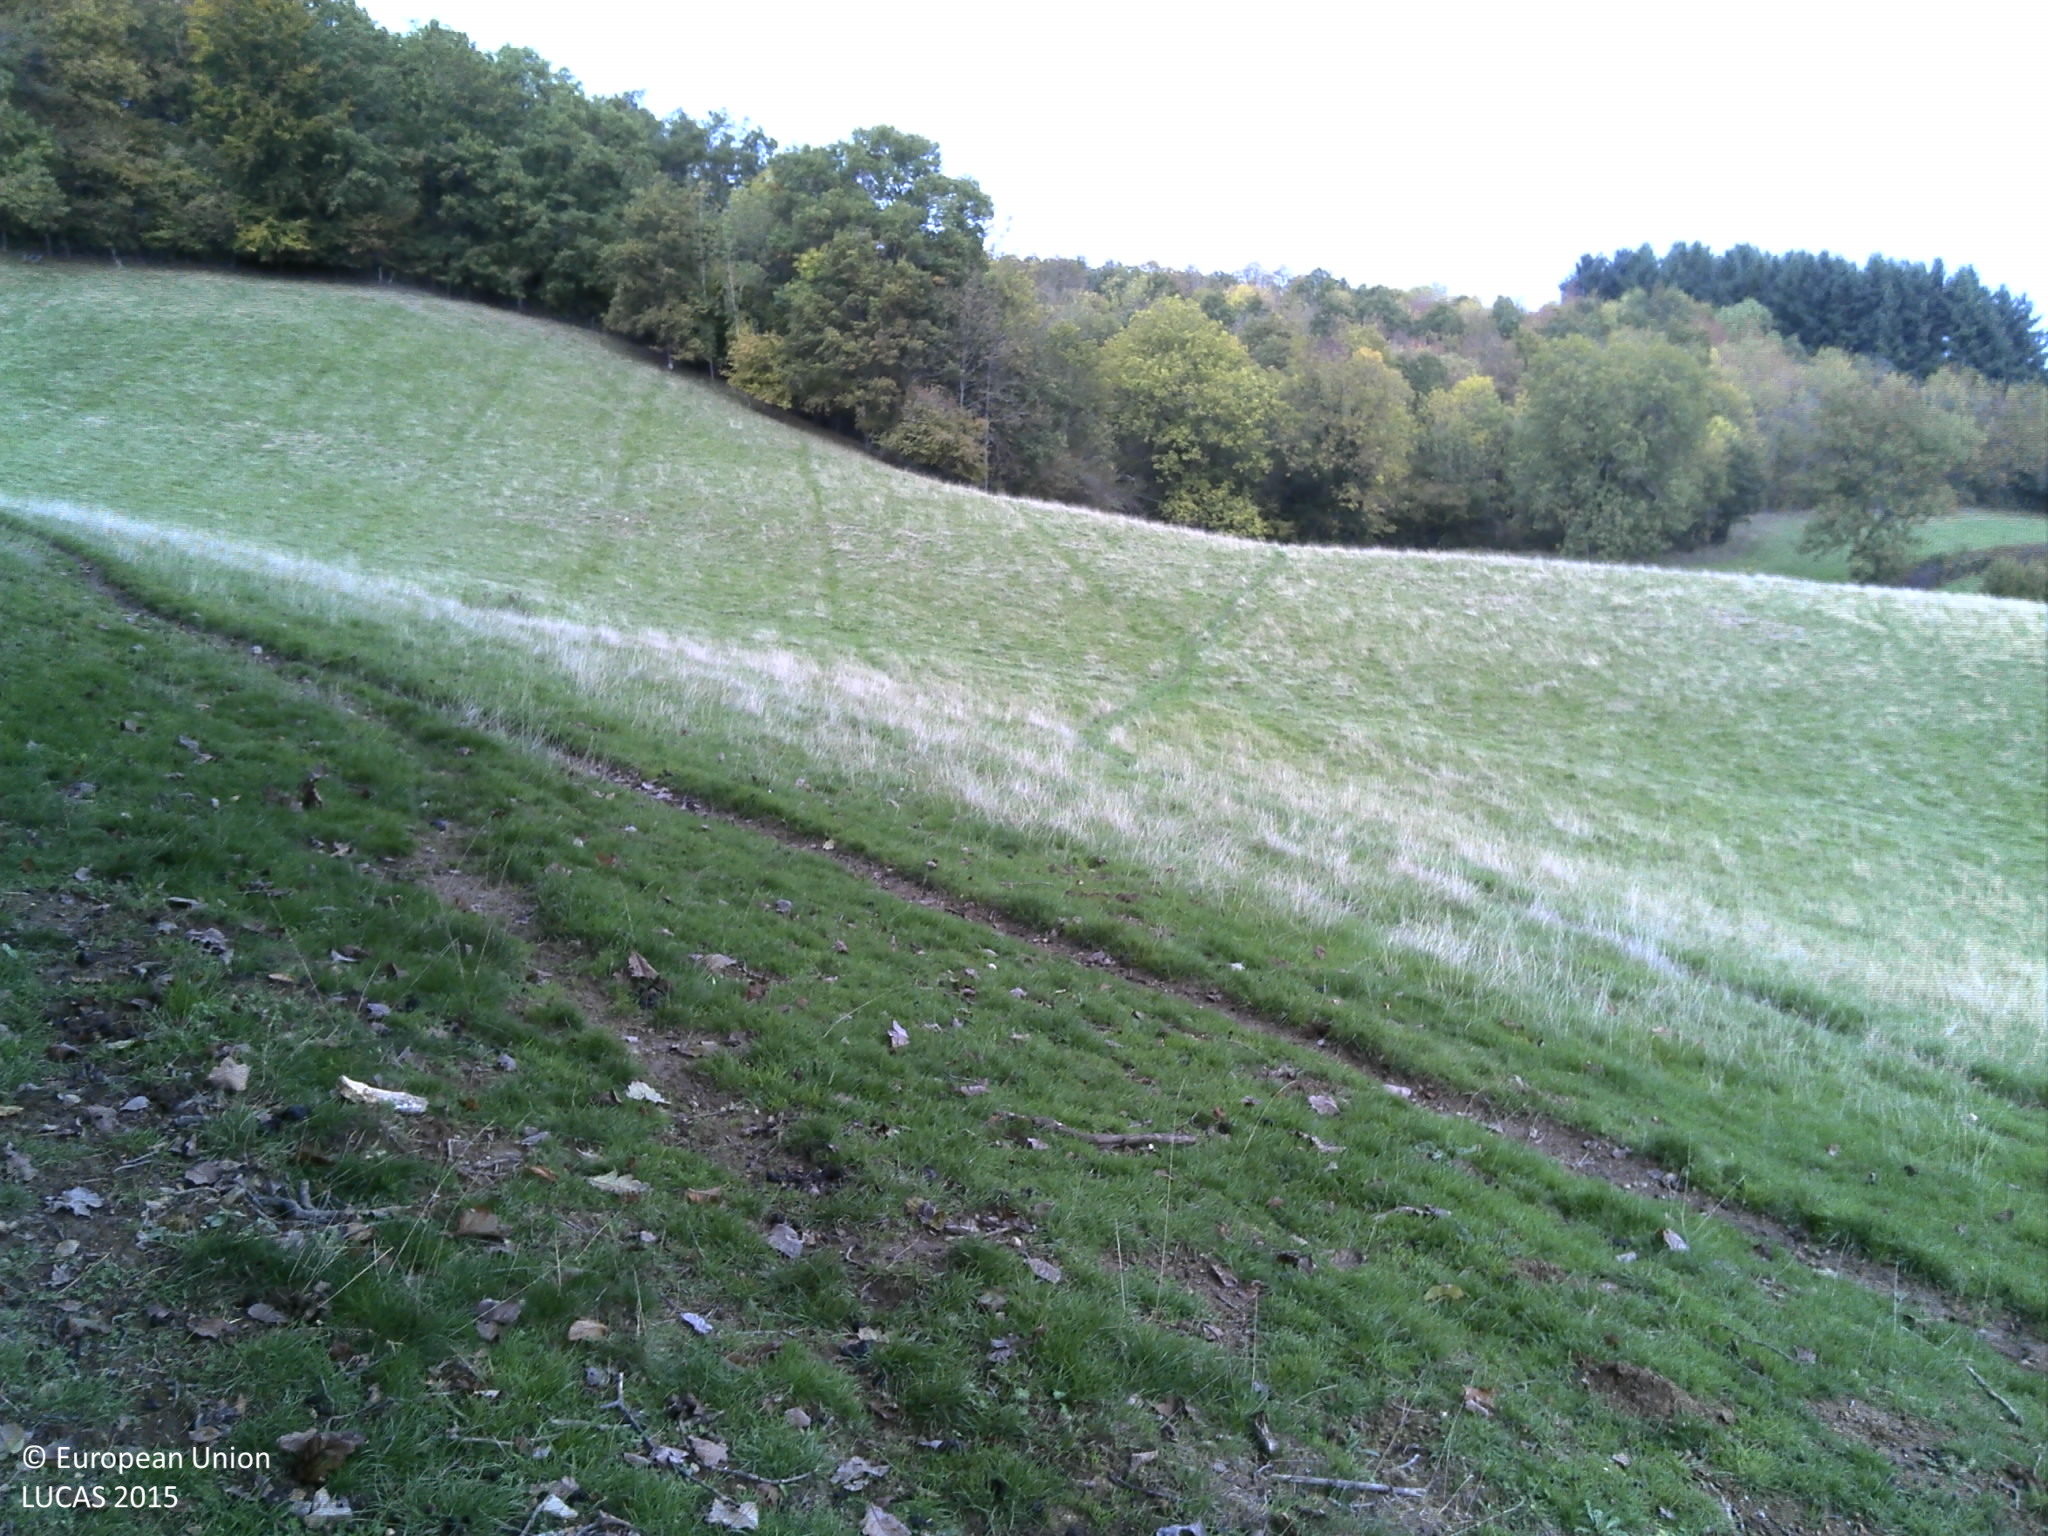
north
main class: Woodland
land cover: Broadleaved woodland
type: mesophytic deciduous forest
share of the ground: > 75 %
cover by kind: broadleaved forest trees 100 %
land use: Forestry
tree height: > 5 m
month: October
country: FR
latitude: 46.6897
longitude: 4.0242
